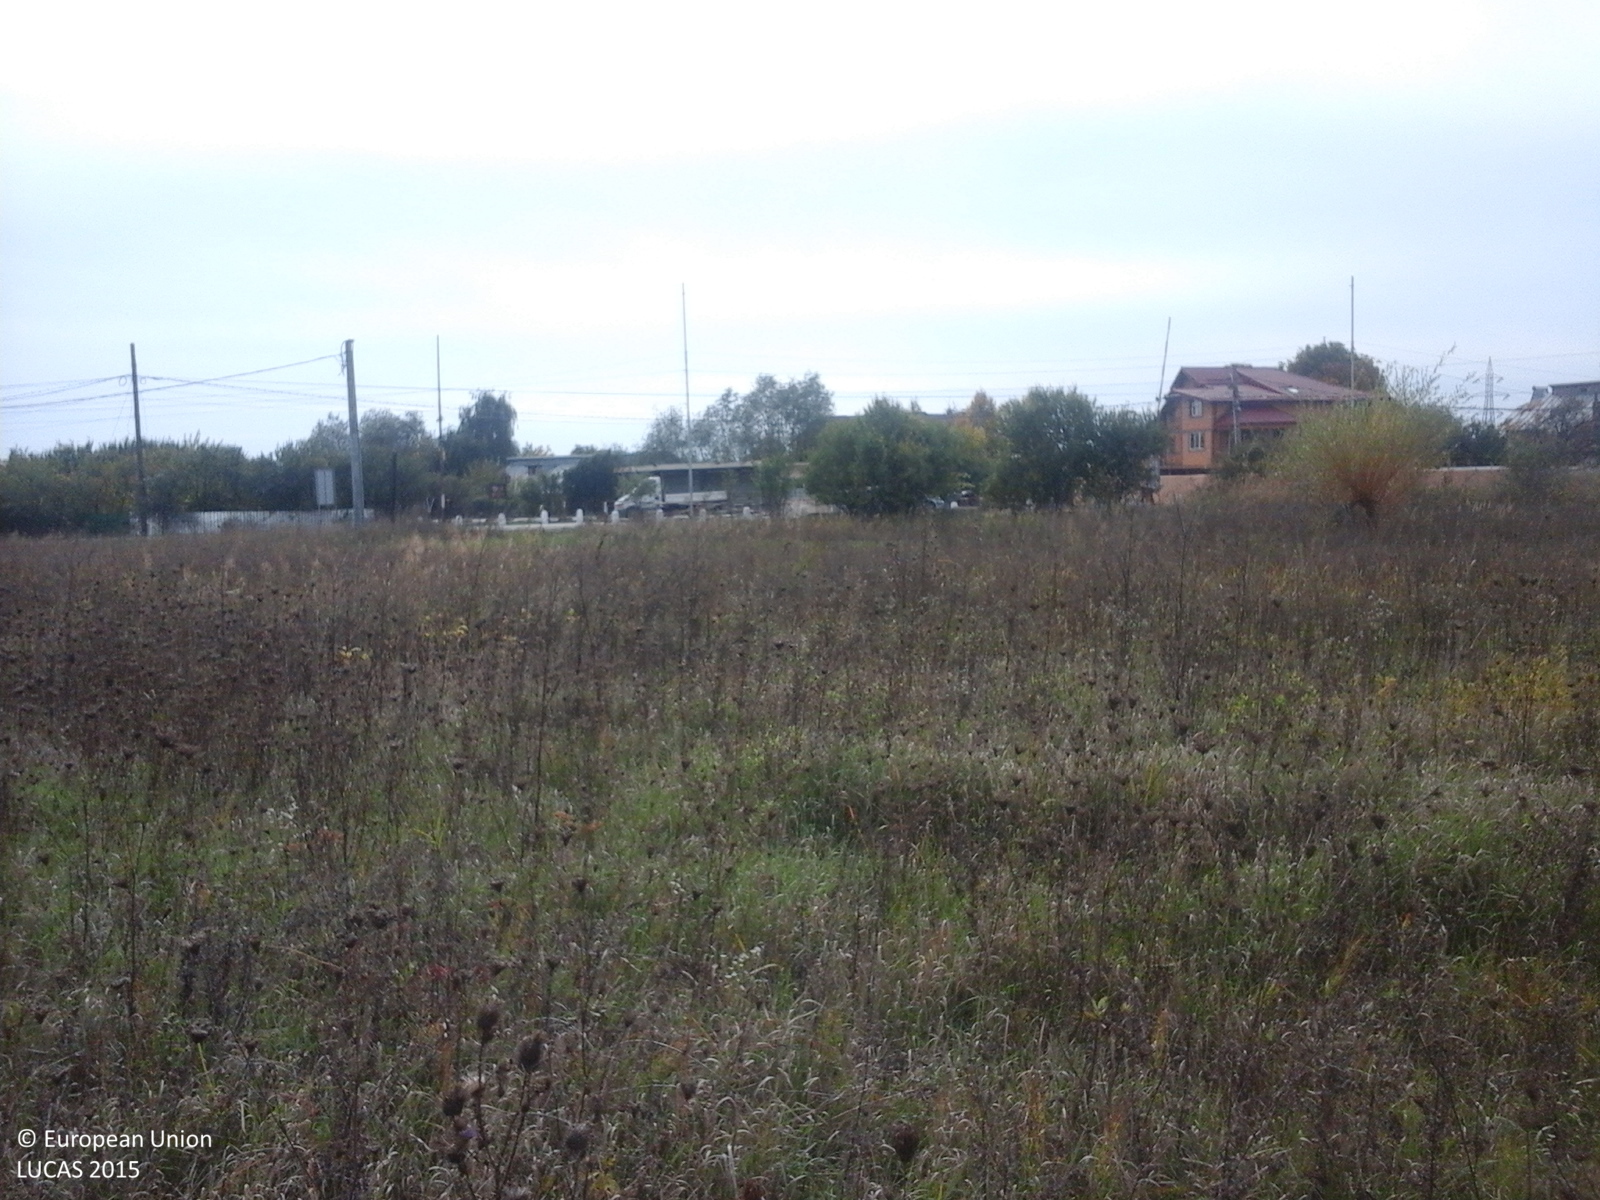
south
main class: Grassland
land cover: Spontaneously vegetated surfaces
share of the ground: > 75 %
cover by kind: herbaceous plants 100 %
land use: Agriculture (excluding fallow land and kitchen gardens)
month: October
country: RO
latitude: 44.9388
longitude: 25.4927
